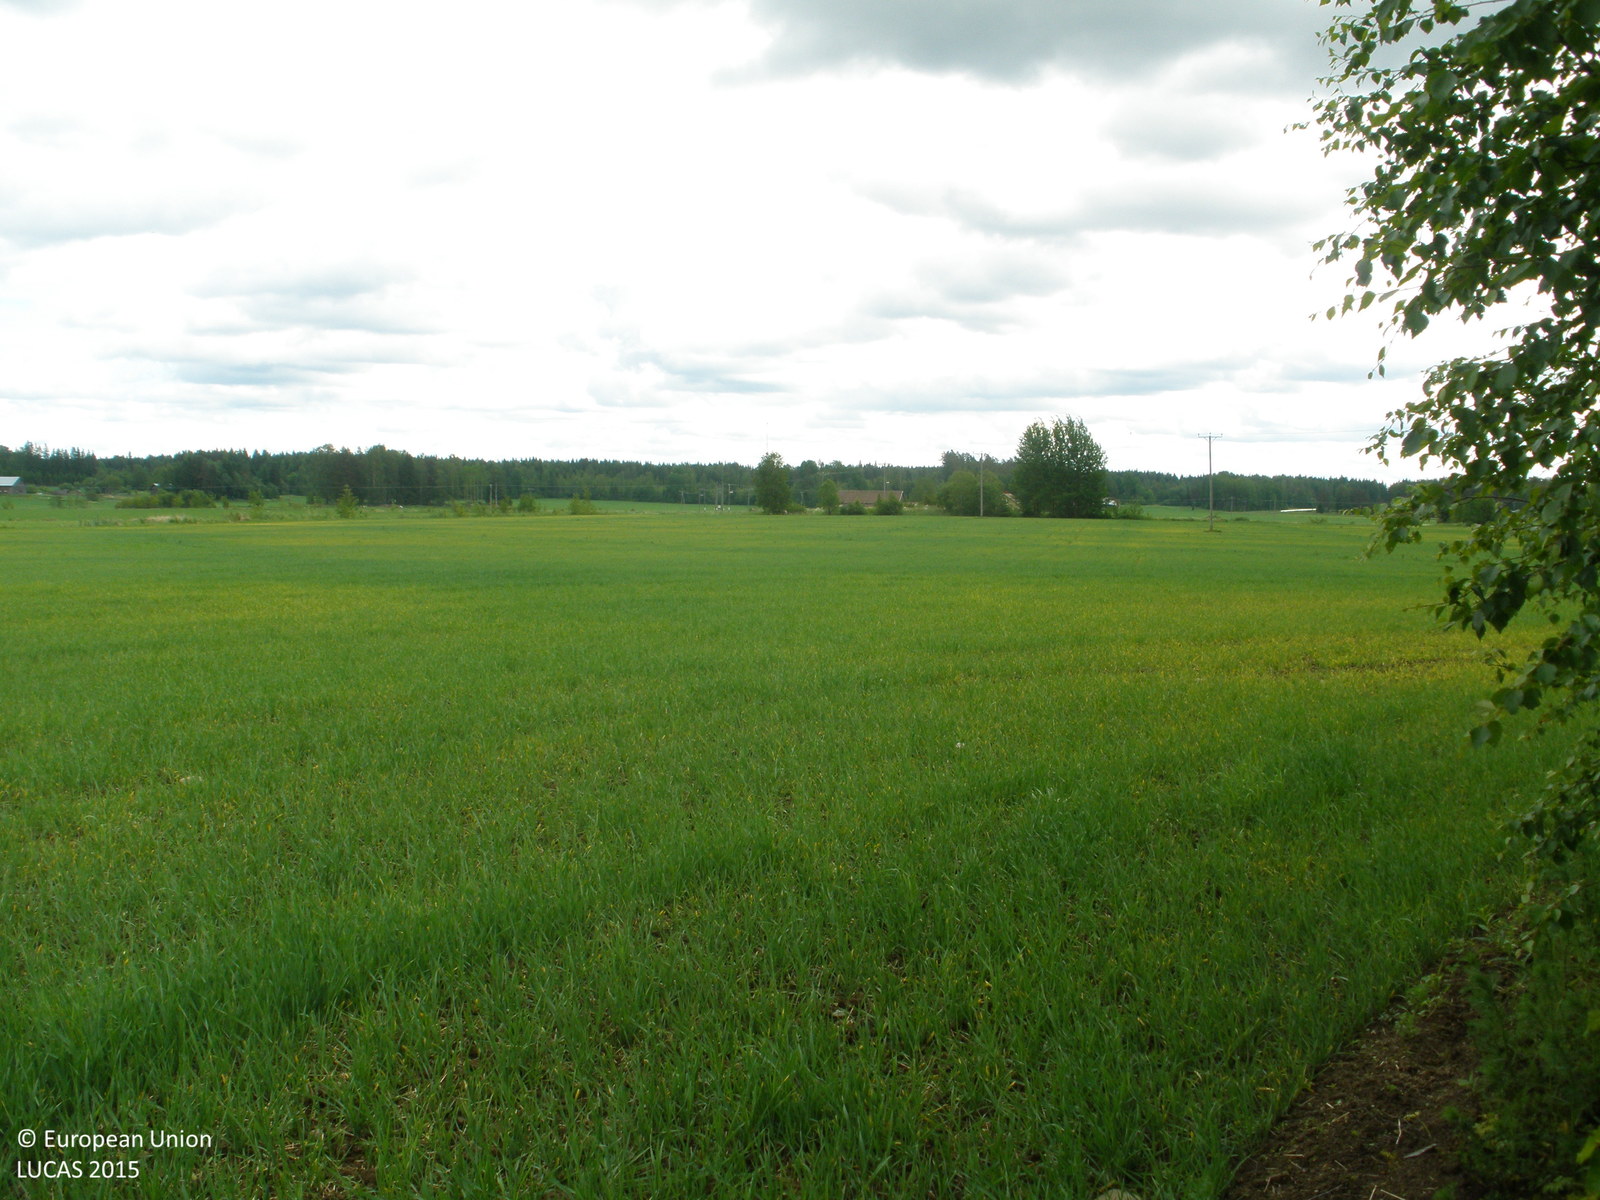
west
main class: Cropland
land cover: Barley
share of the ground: 25 - 50 %
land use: Agriculture (excluding fallow land and kitchen gardens)
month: June
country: FI
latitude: 60.9766
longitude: 23.6671
